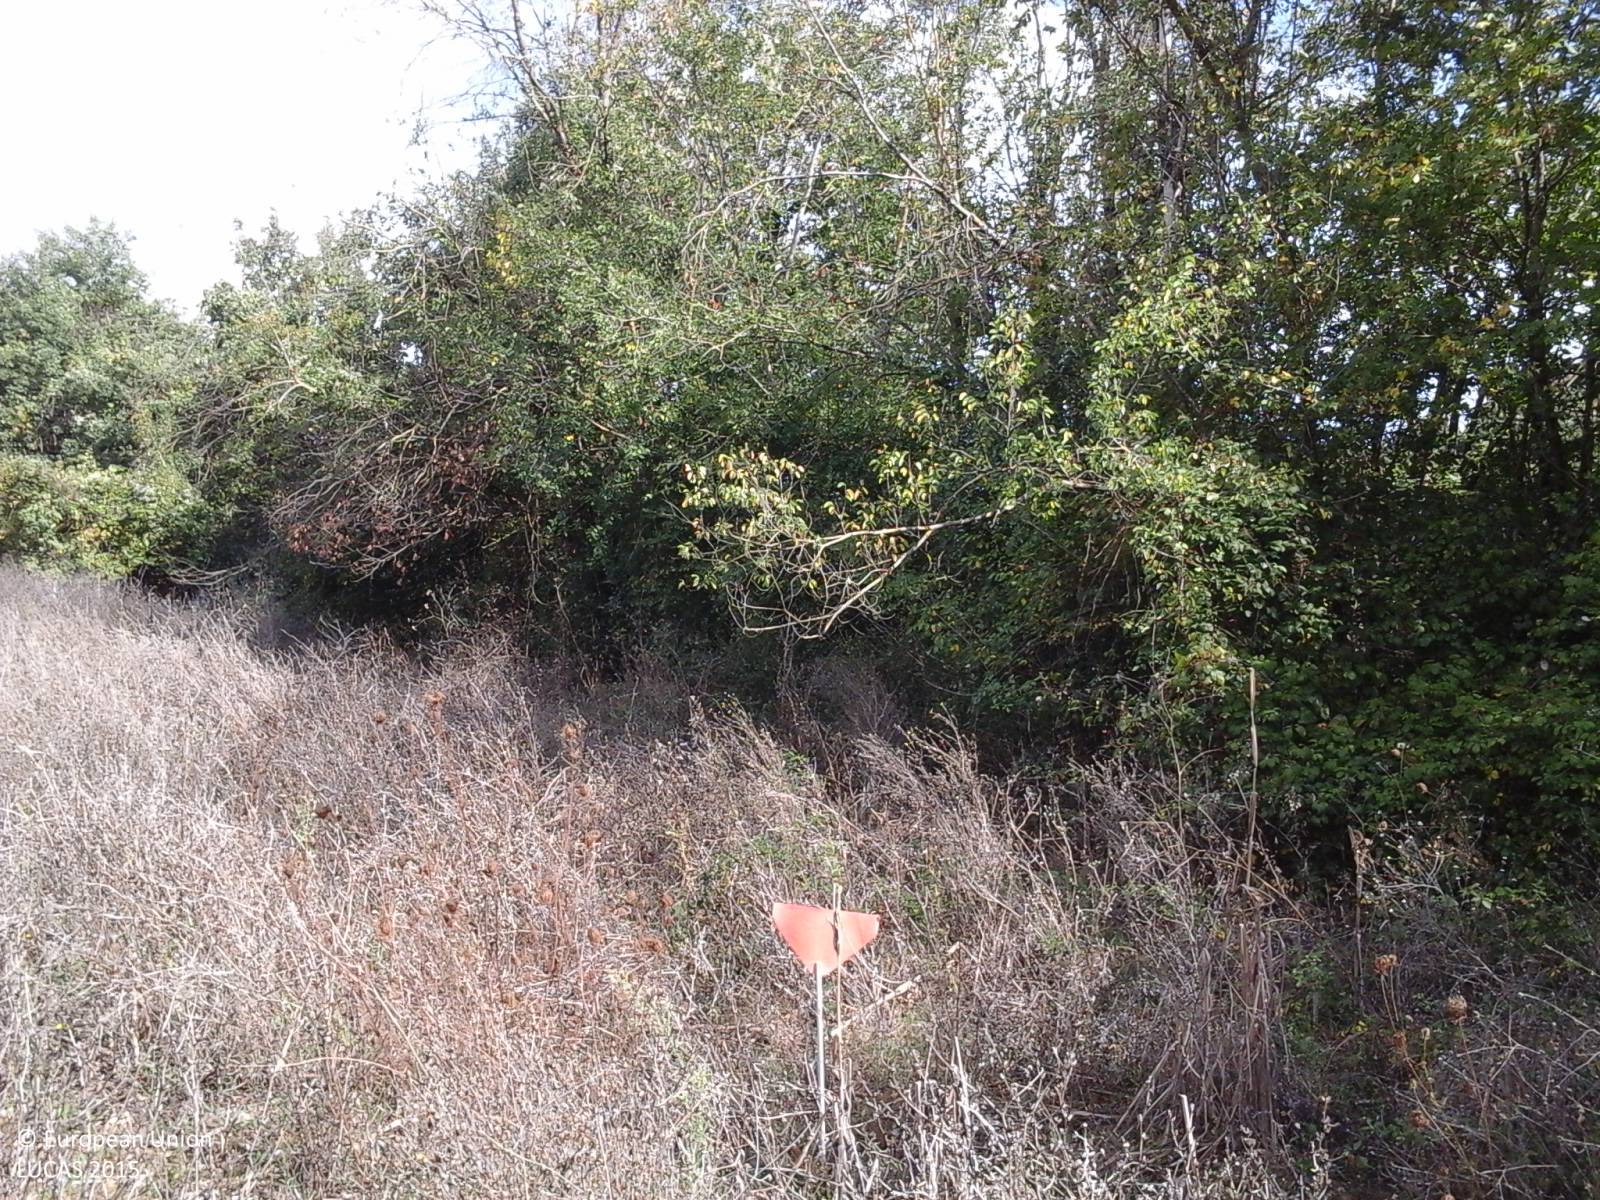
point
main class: Grassland
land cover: Spontaneously vegetated surfaces
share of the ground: 50 - 75 %
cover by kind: herbaceous plants 100 %
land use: Fallow land
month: September
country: IT
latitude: 42.8801
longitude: 12.3313
